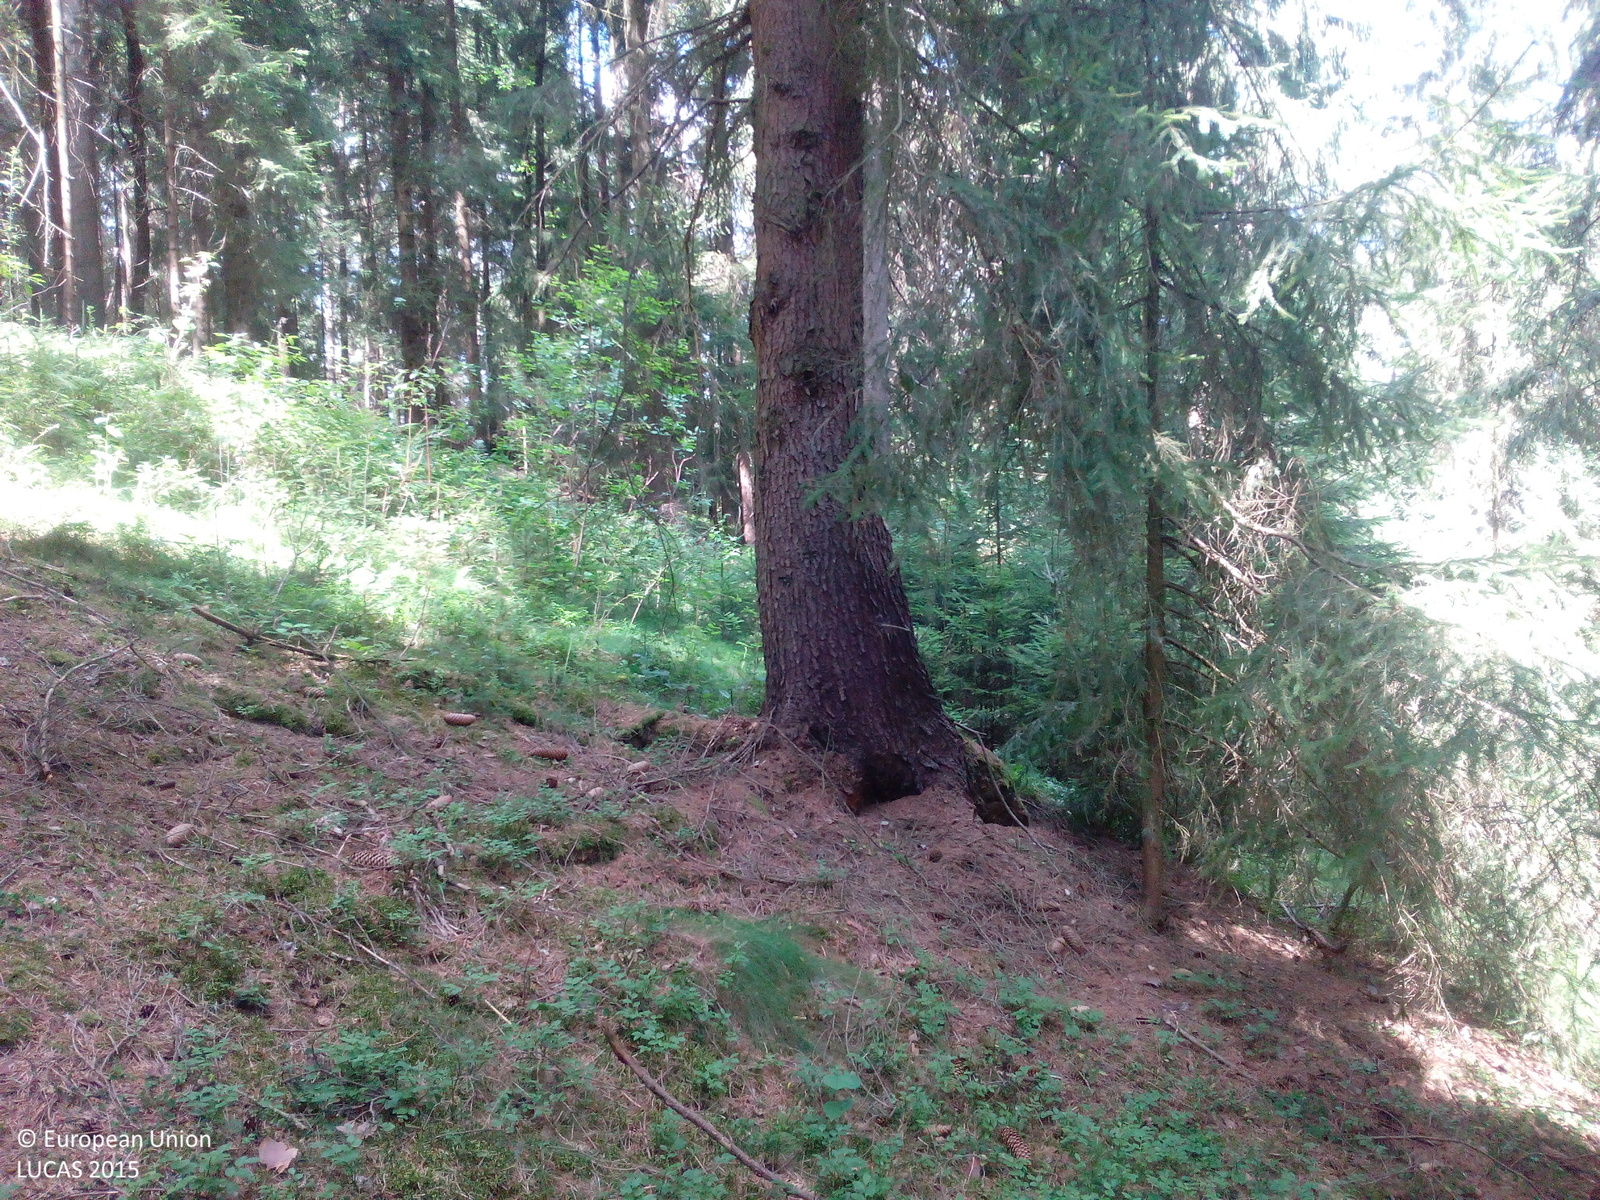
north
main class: Woodland
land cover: Spruce dominated coniferous woodland
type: hemiboreal forest and nemoral coniferous forest and mixed broadleaved-coniferous forest
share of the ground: > 75 %
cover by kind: coniferous forest trees 80 %, unconsolidated bare surface 10 %, shrubs 5 %, lichens and mosses 5 %
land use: Forestry
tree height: > 5 m
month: July
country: DE
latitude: 49.5868
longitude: 12.2266
